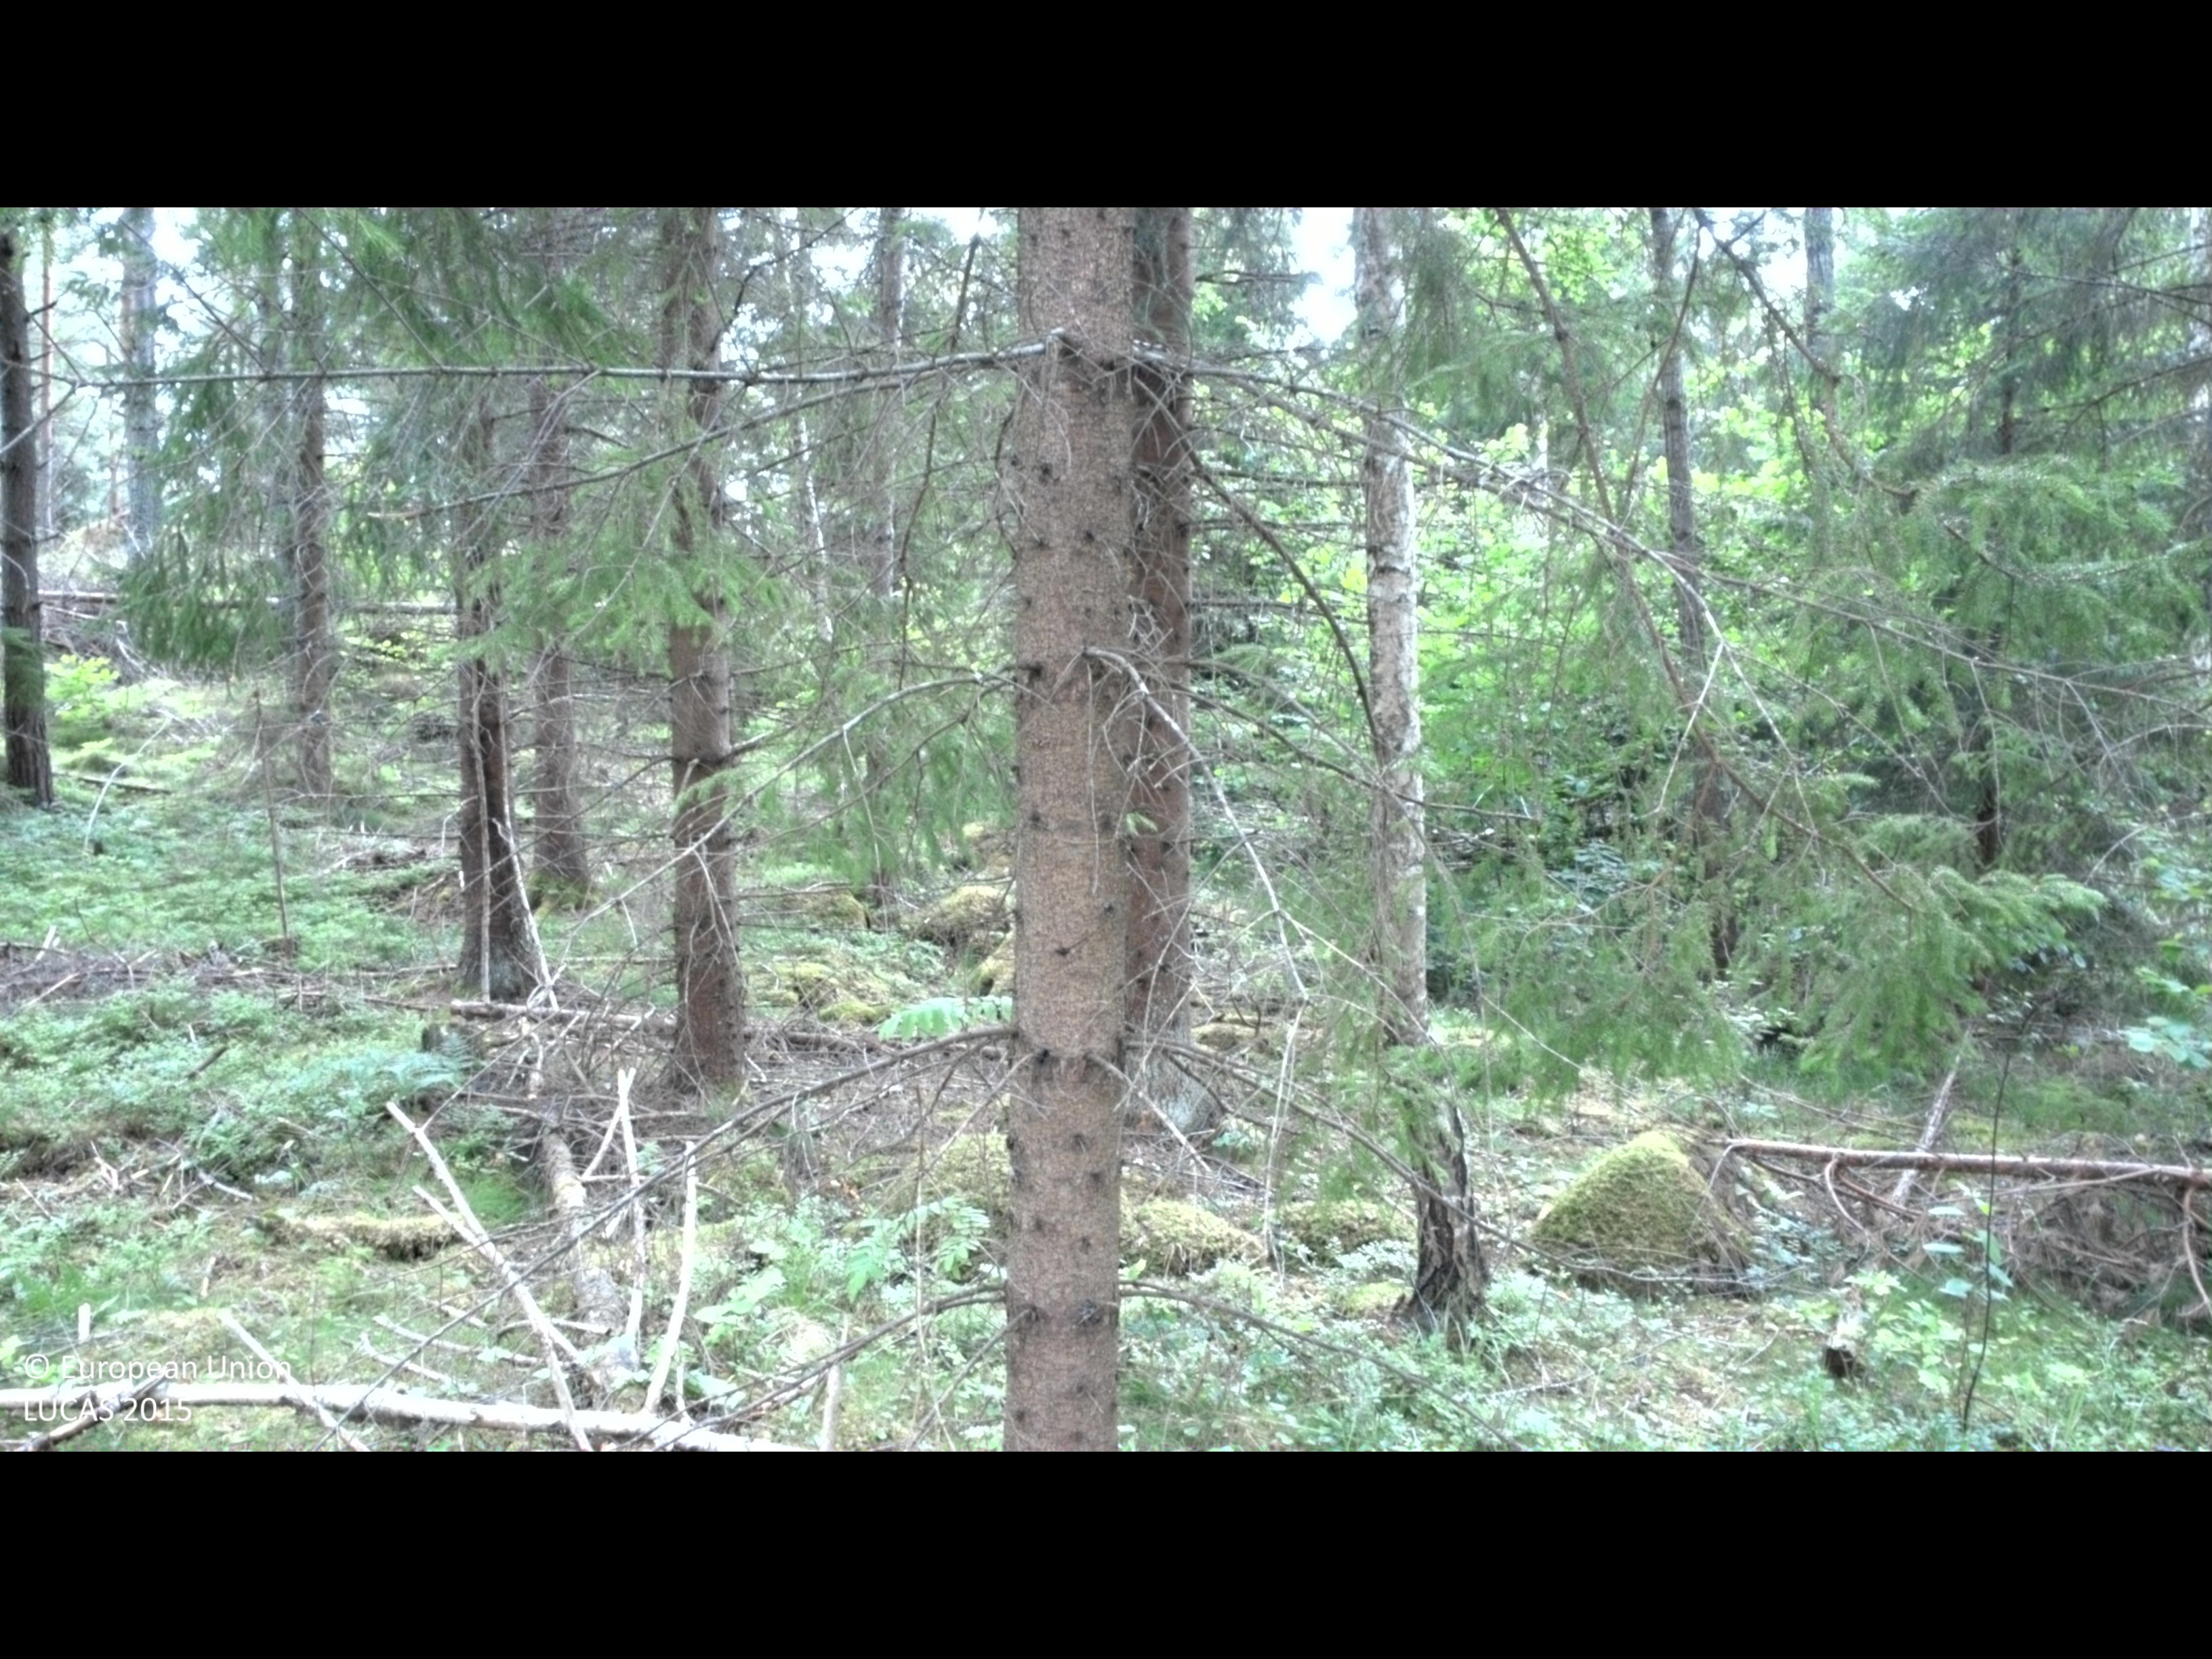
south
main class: Woodland
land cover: Other coniferous woodland
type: boreal forest
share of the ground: 50 - 75 %
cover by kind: coniferous forest trees 60 %, shrubs 25 %, herbaceous plants 10 %, broadleaved forest trees 5 %
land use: Forestry
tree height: > 5 m
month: July
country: SE
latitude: 57.9175
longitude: 16.1246
